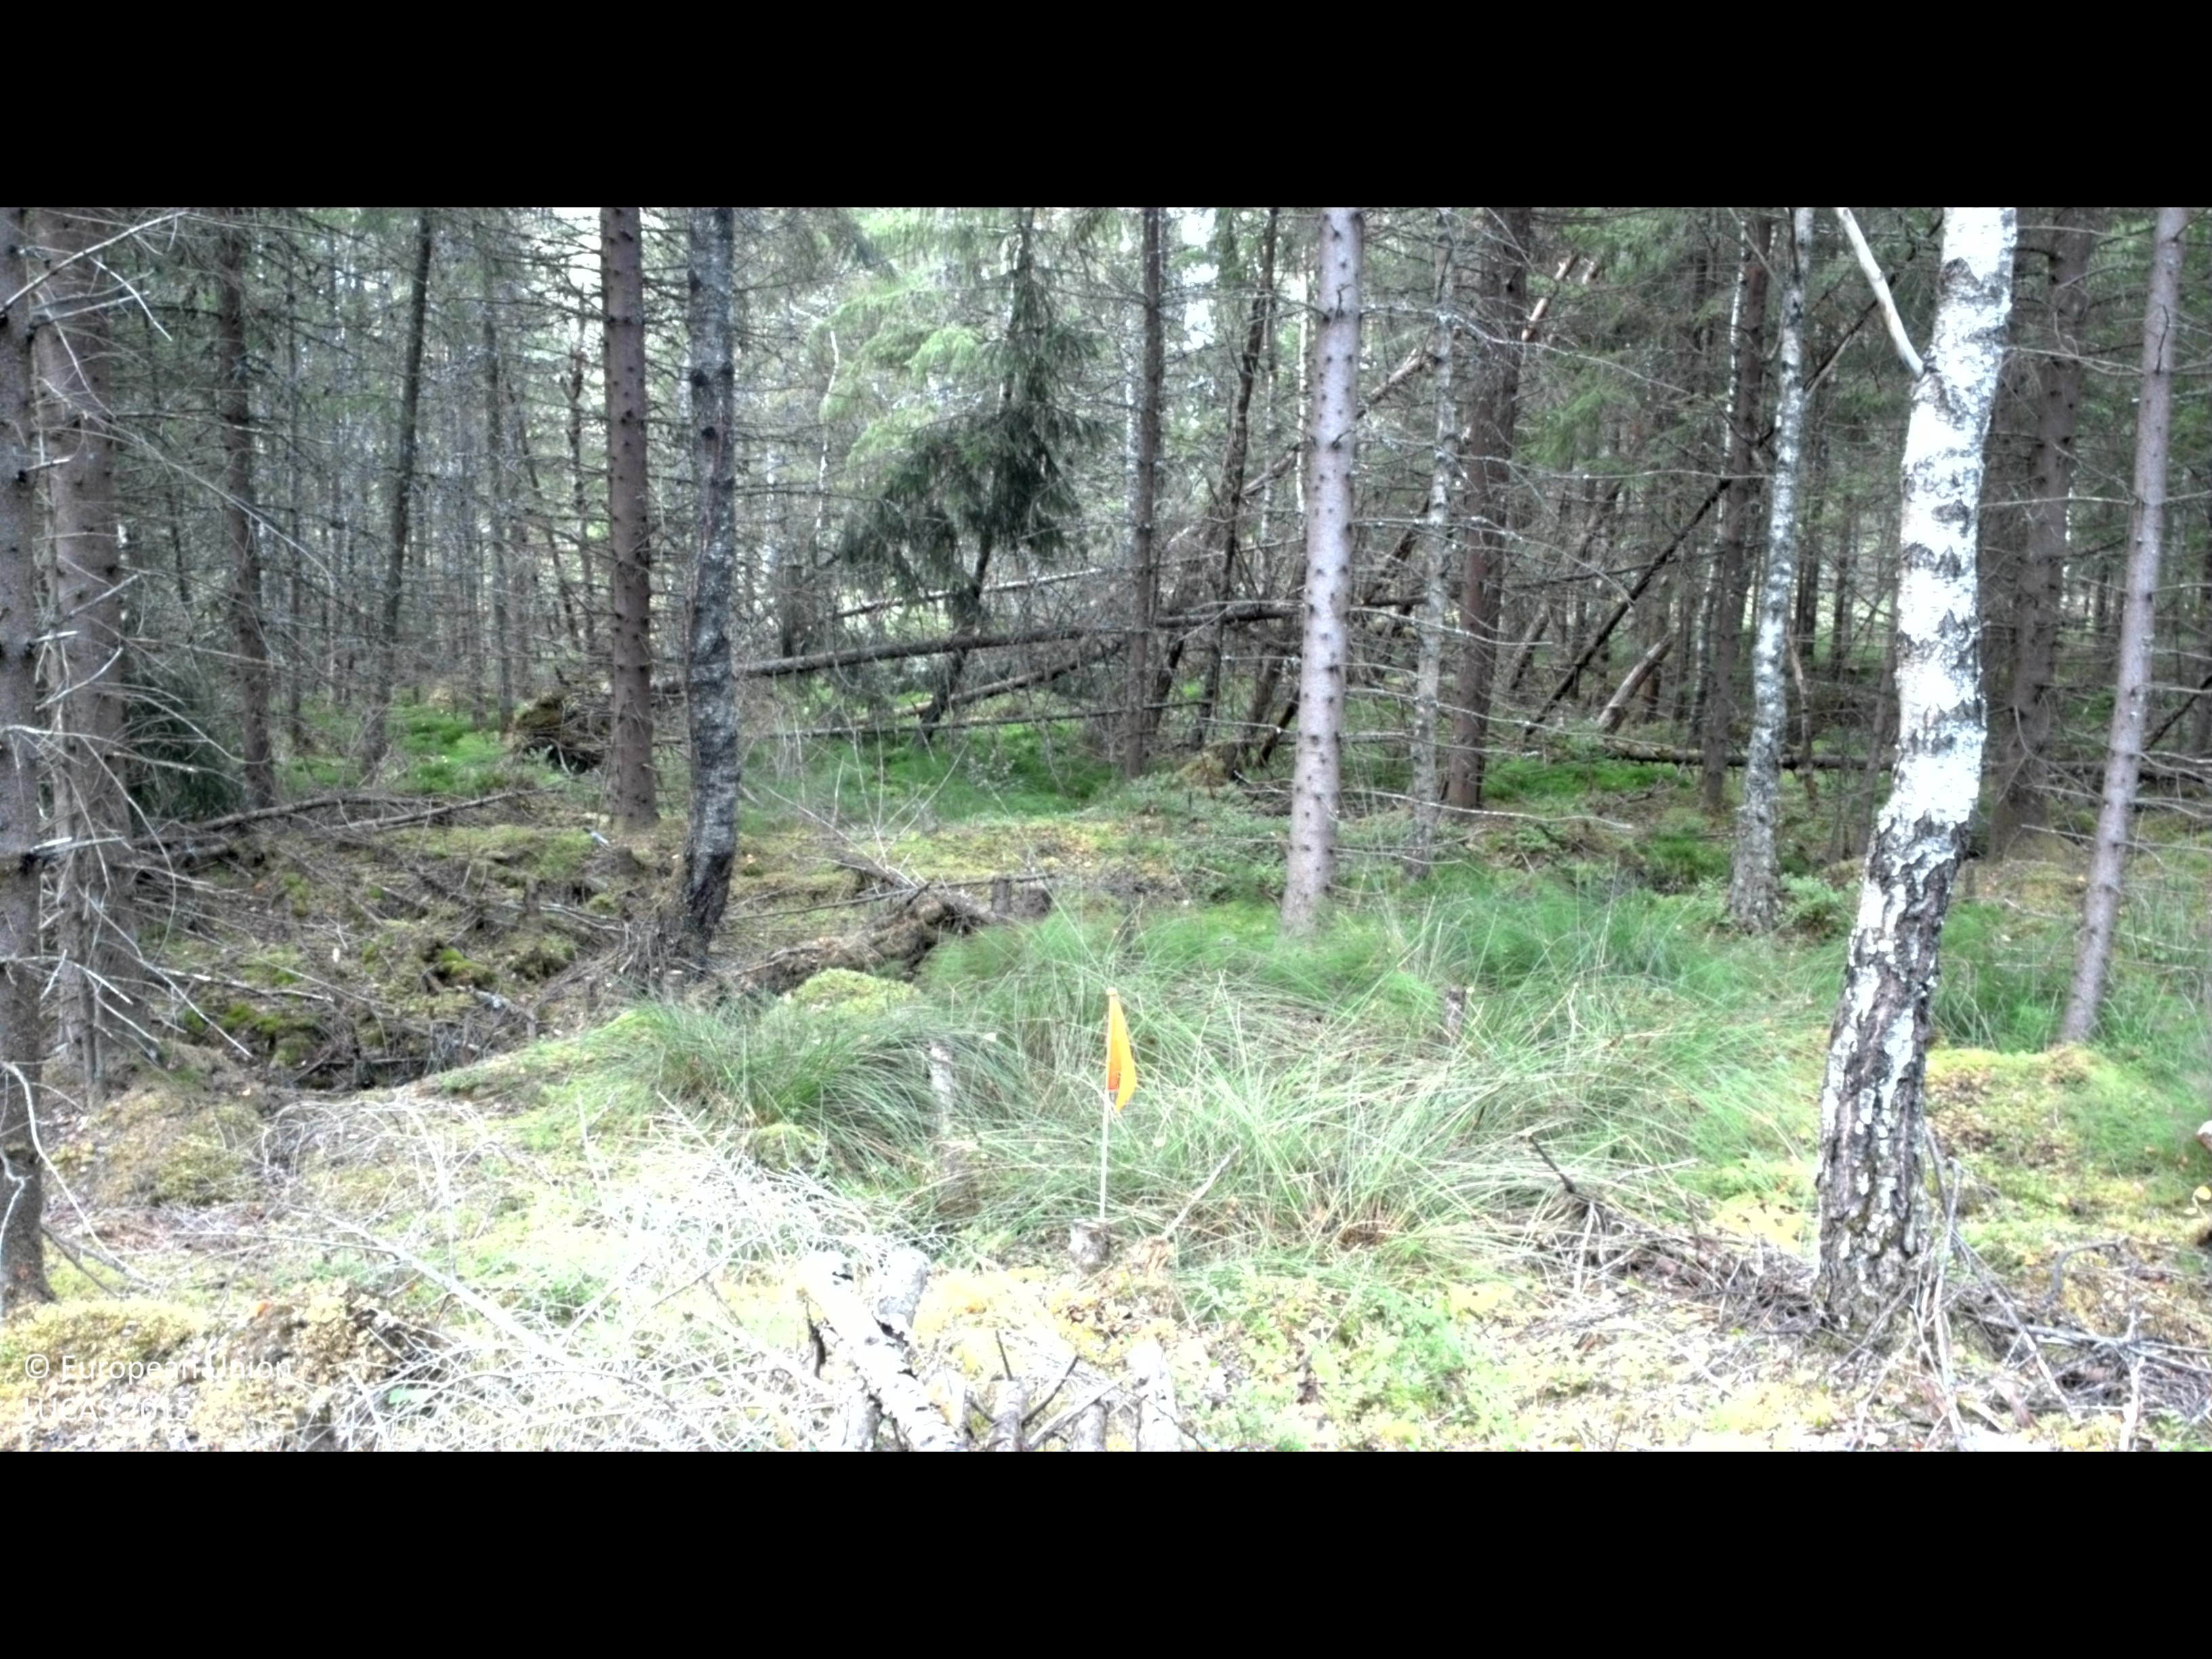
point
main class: Woodland
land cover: Spruce dominated coniferous woodland
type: boreal forest
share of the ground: 50 - 75 %
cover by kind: coniferous forest trees 60 %, shrubs 20 %, broadleaved forest trees 15 %, herbaceous plants 5 %
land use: Forestry
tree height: > 5 m
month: August
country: SE
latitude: 57.1731
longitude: 13.8828
